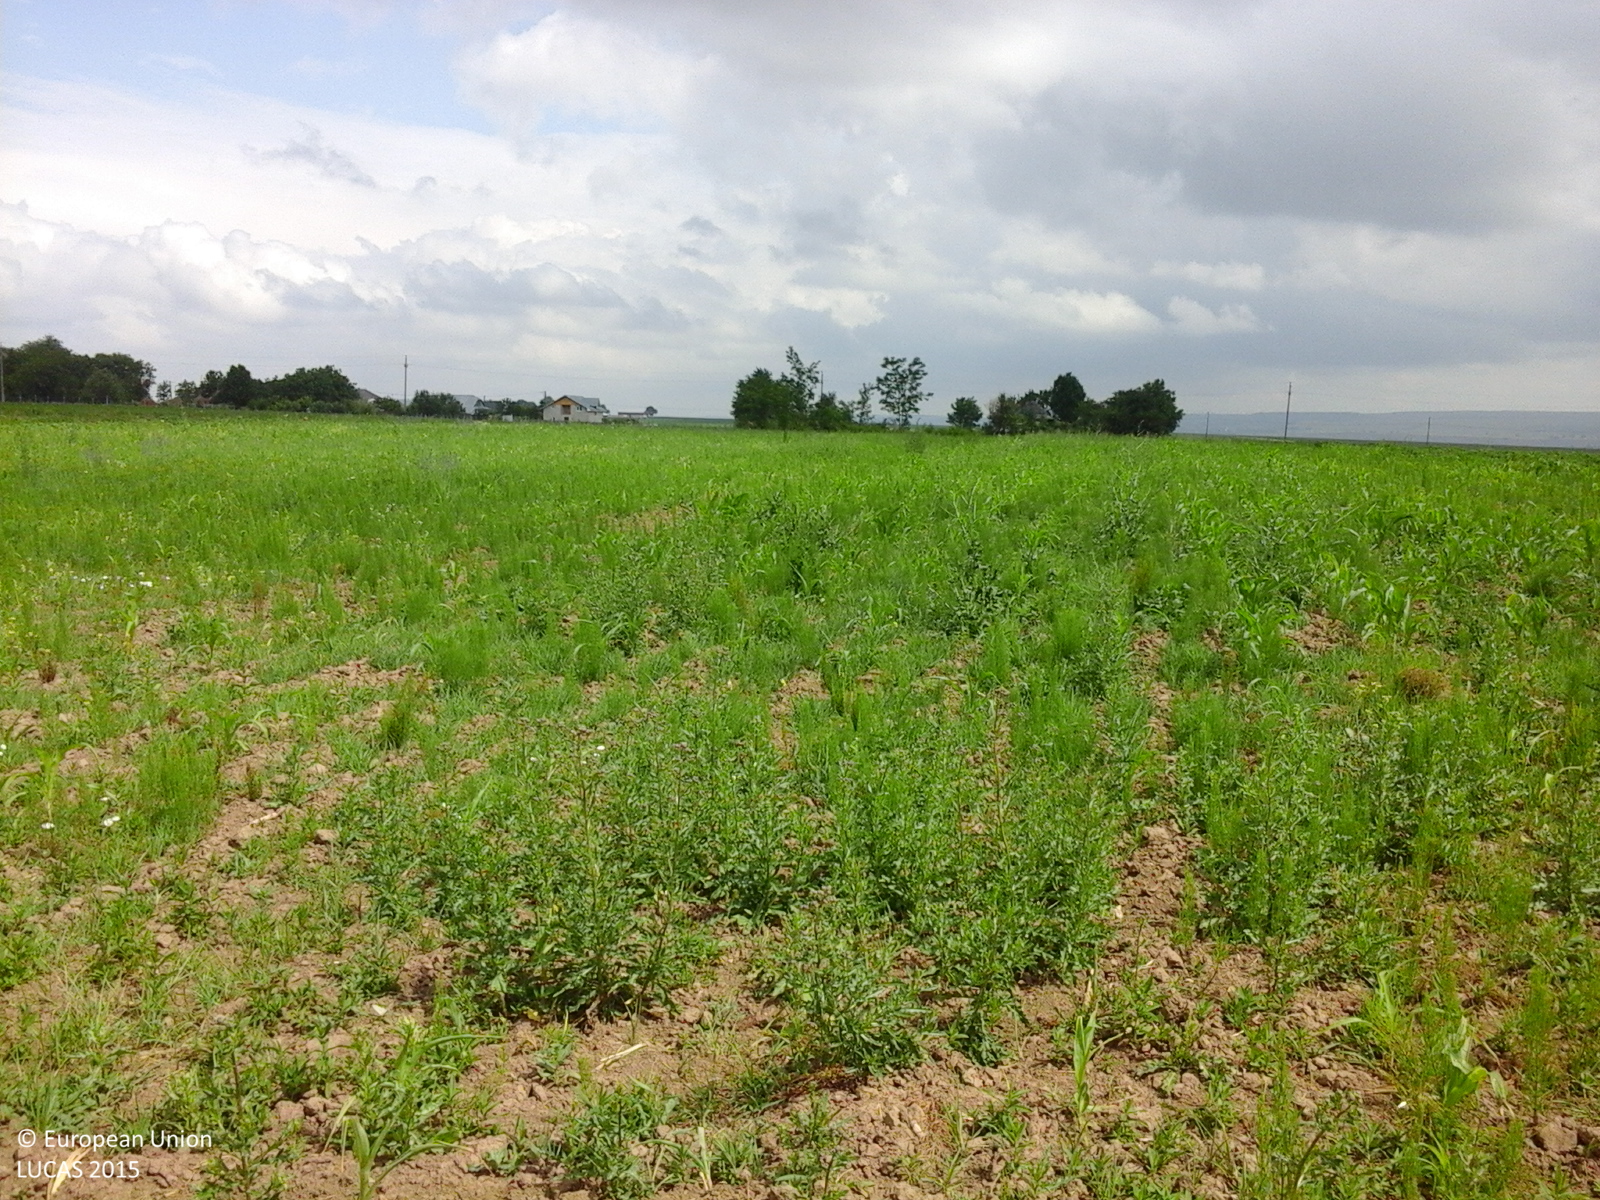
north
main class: Cropland
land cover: Sunflower
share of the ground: 25 - 50 %
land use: Agriculture (excluding fallow land and kitchen gardens)
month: June
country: RO
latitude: 47.0789
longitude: 26.6183
